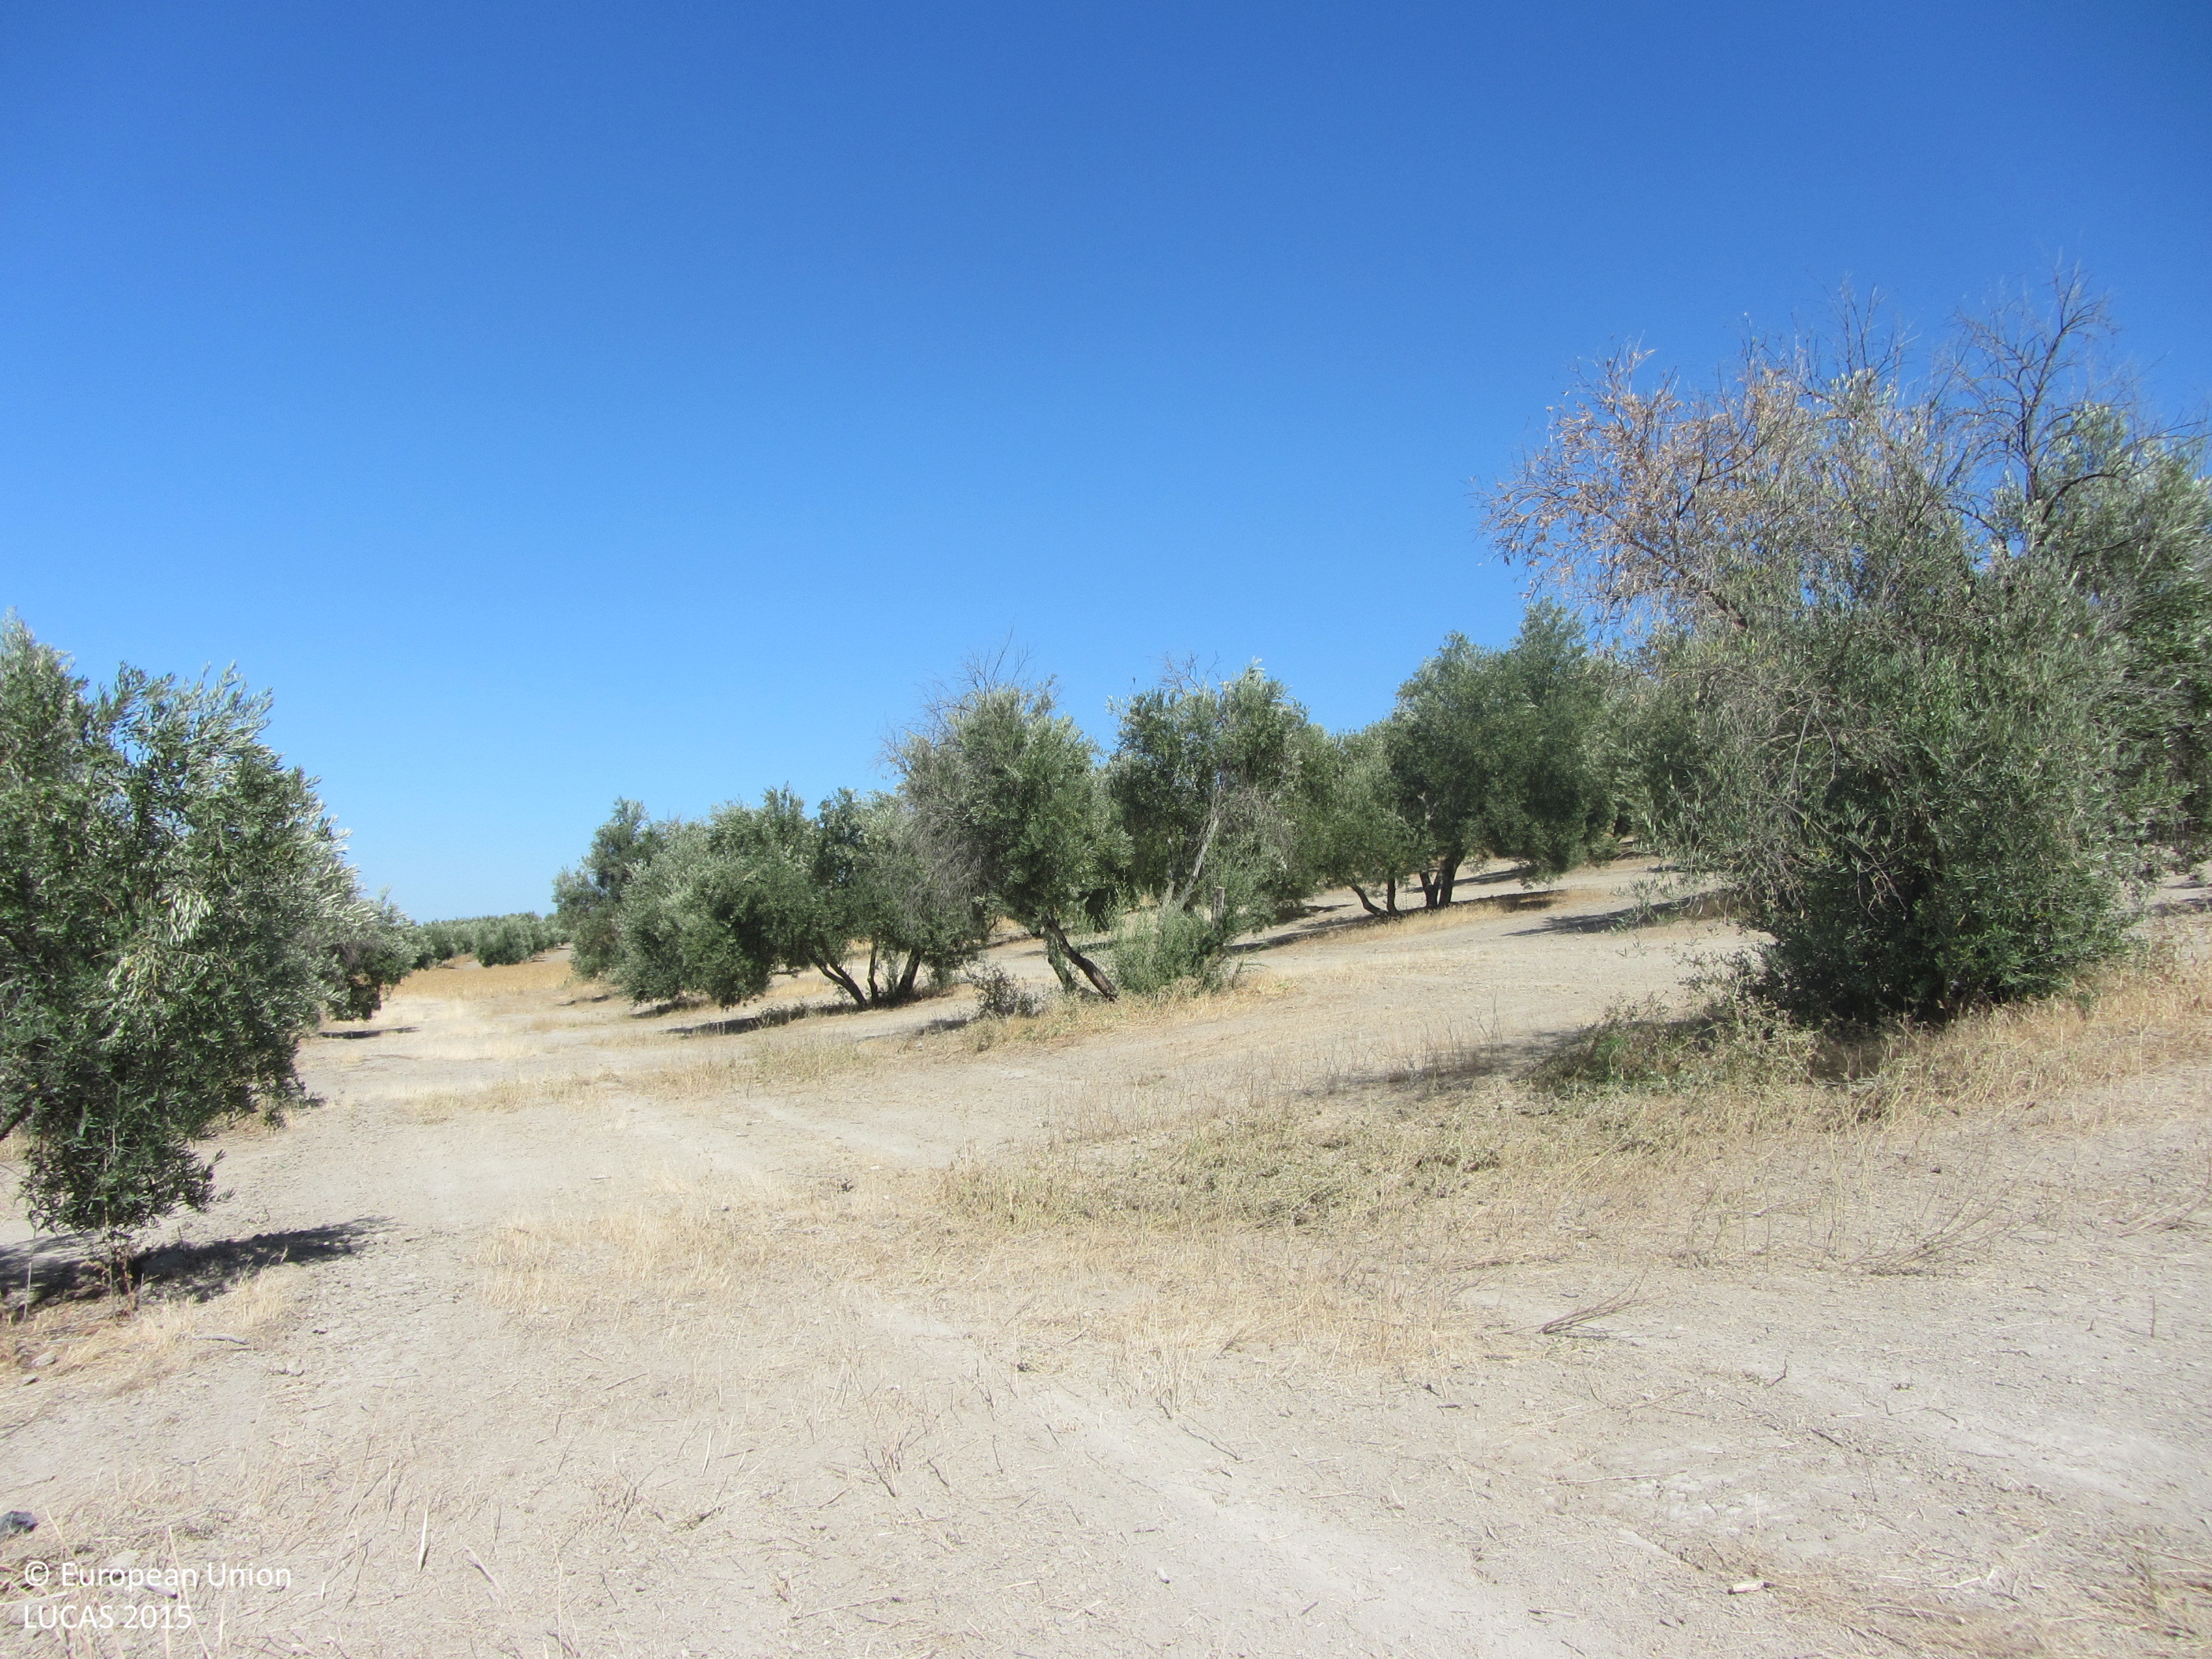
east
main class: Cropland
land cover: Olive groves
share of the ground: 25 - 50 %
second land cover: Other bare soil
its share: > 75 %
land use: Agriculture (excluding fallow land and kitchen gardens)
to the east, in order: Olive groves; Other bare soil; Other fibre and oleaginous crops; Olive groves
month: July
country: ES
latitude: 37.9761
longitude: -3.8592
